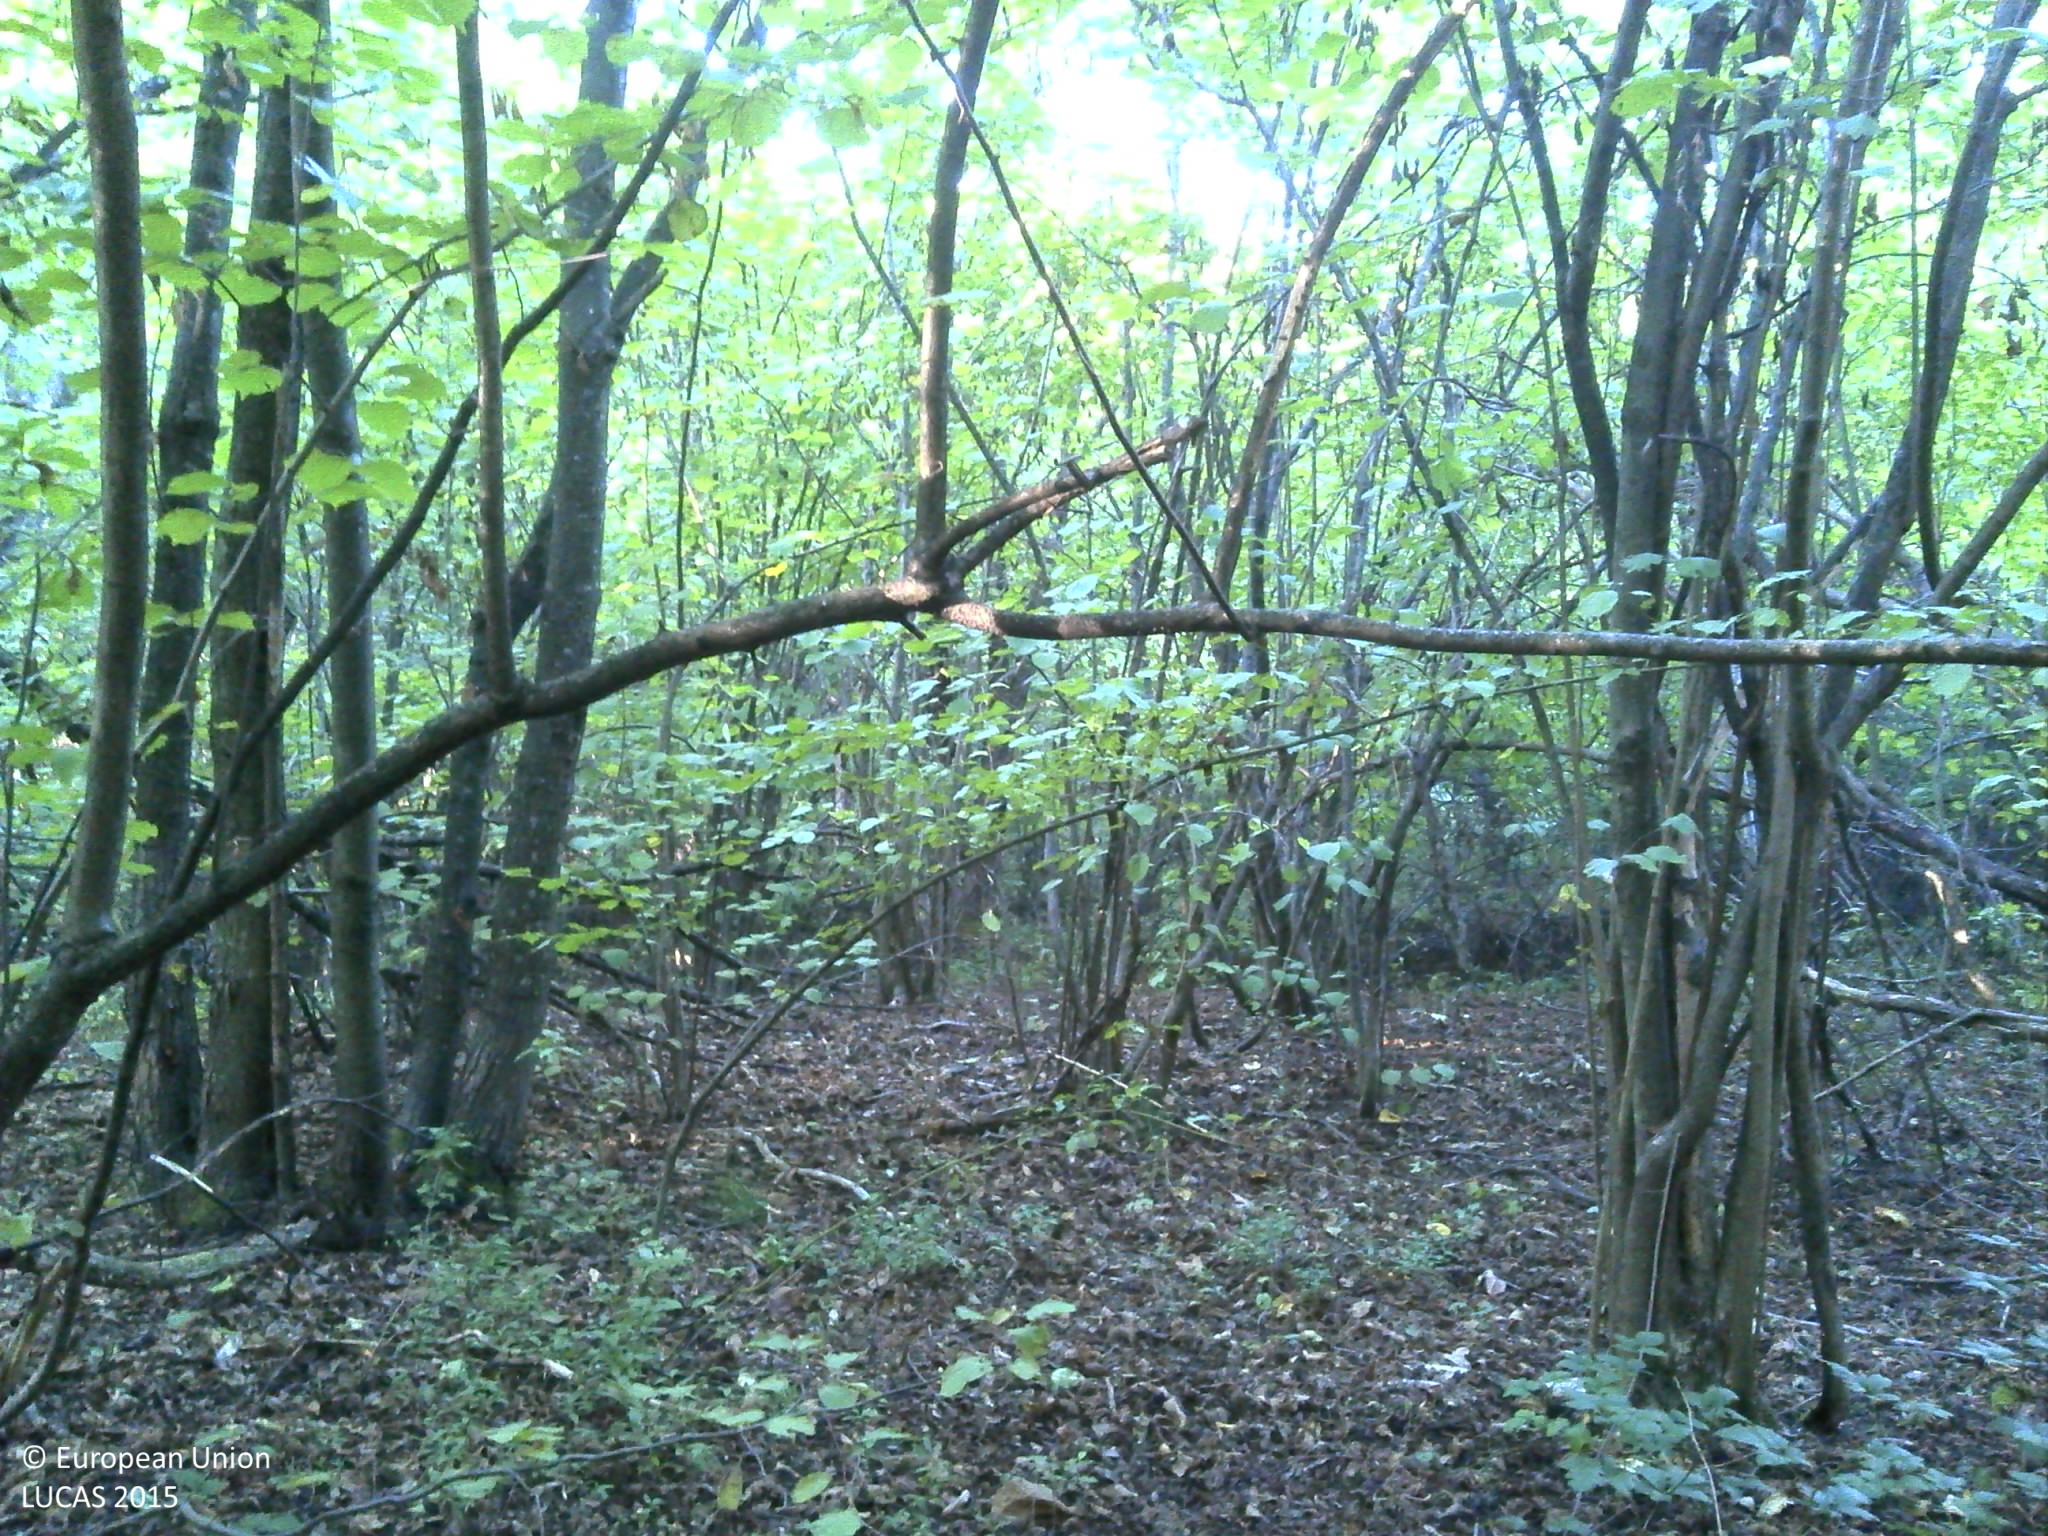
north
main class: Woodland
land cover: Broadleaved woodland
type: acidophilous oak and oak-birch forest
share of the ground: > 75 %
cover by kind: broadleaved forest trees 100 %
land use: Forestry
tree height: > 5 m
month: August
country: HR
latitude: 45.3140
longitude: 16.3368
